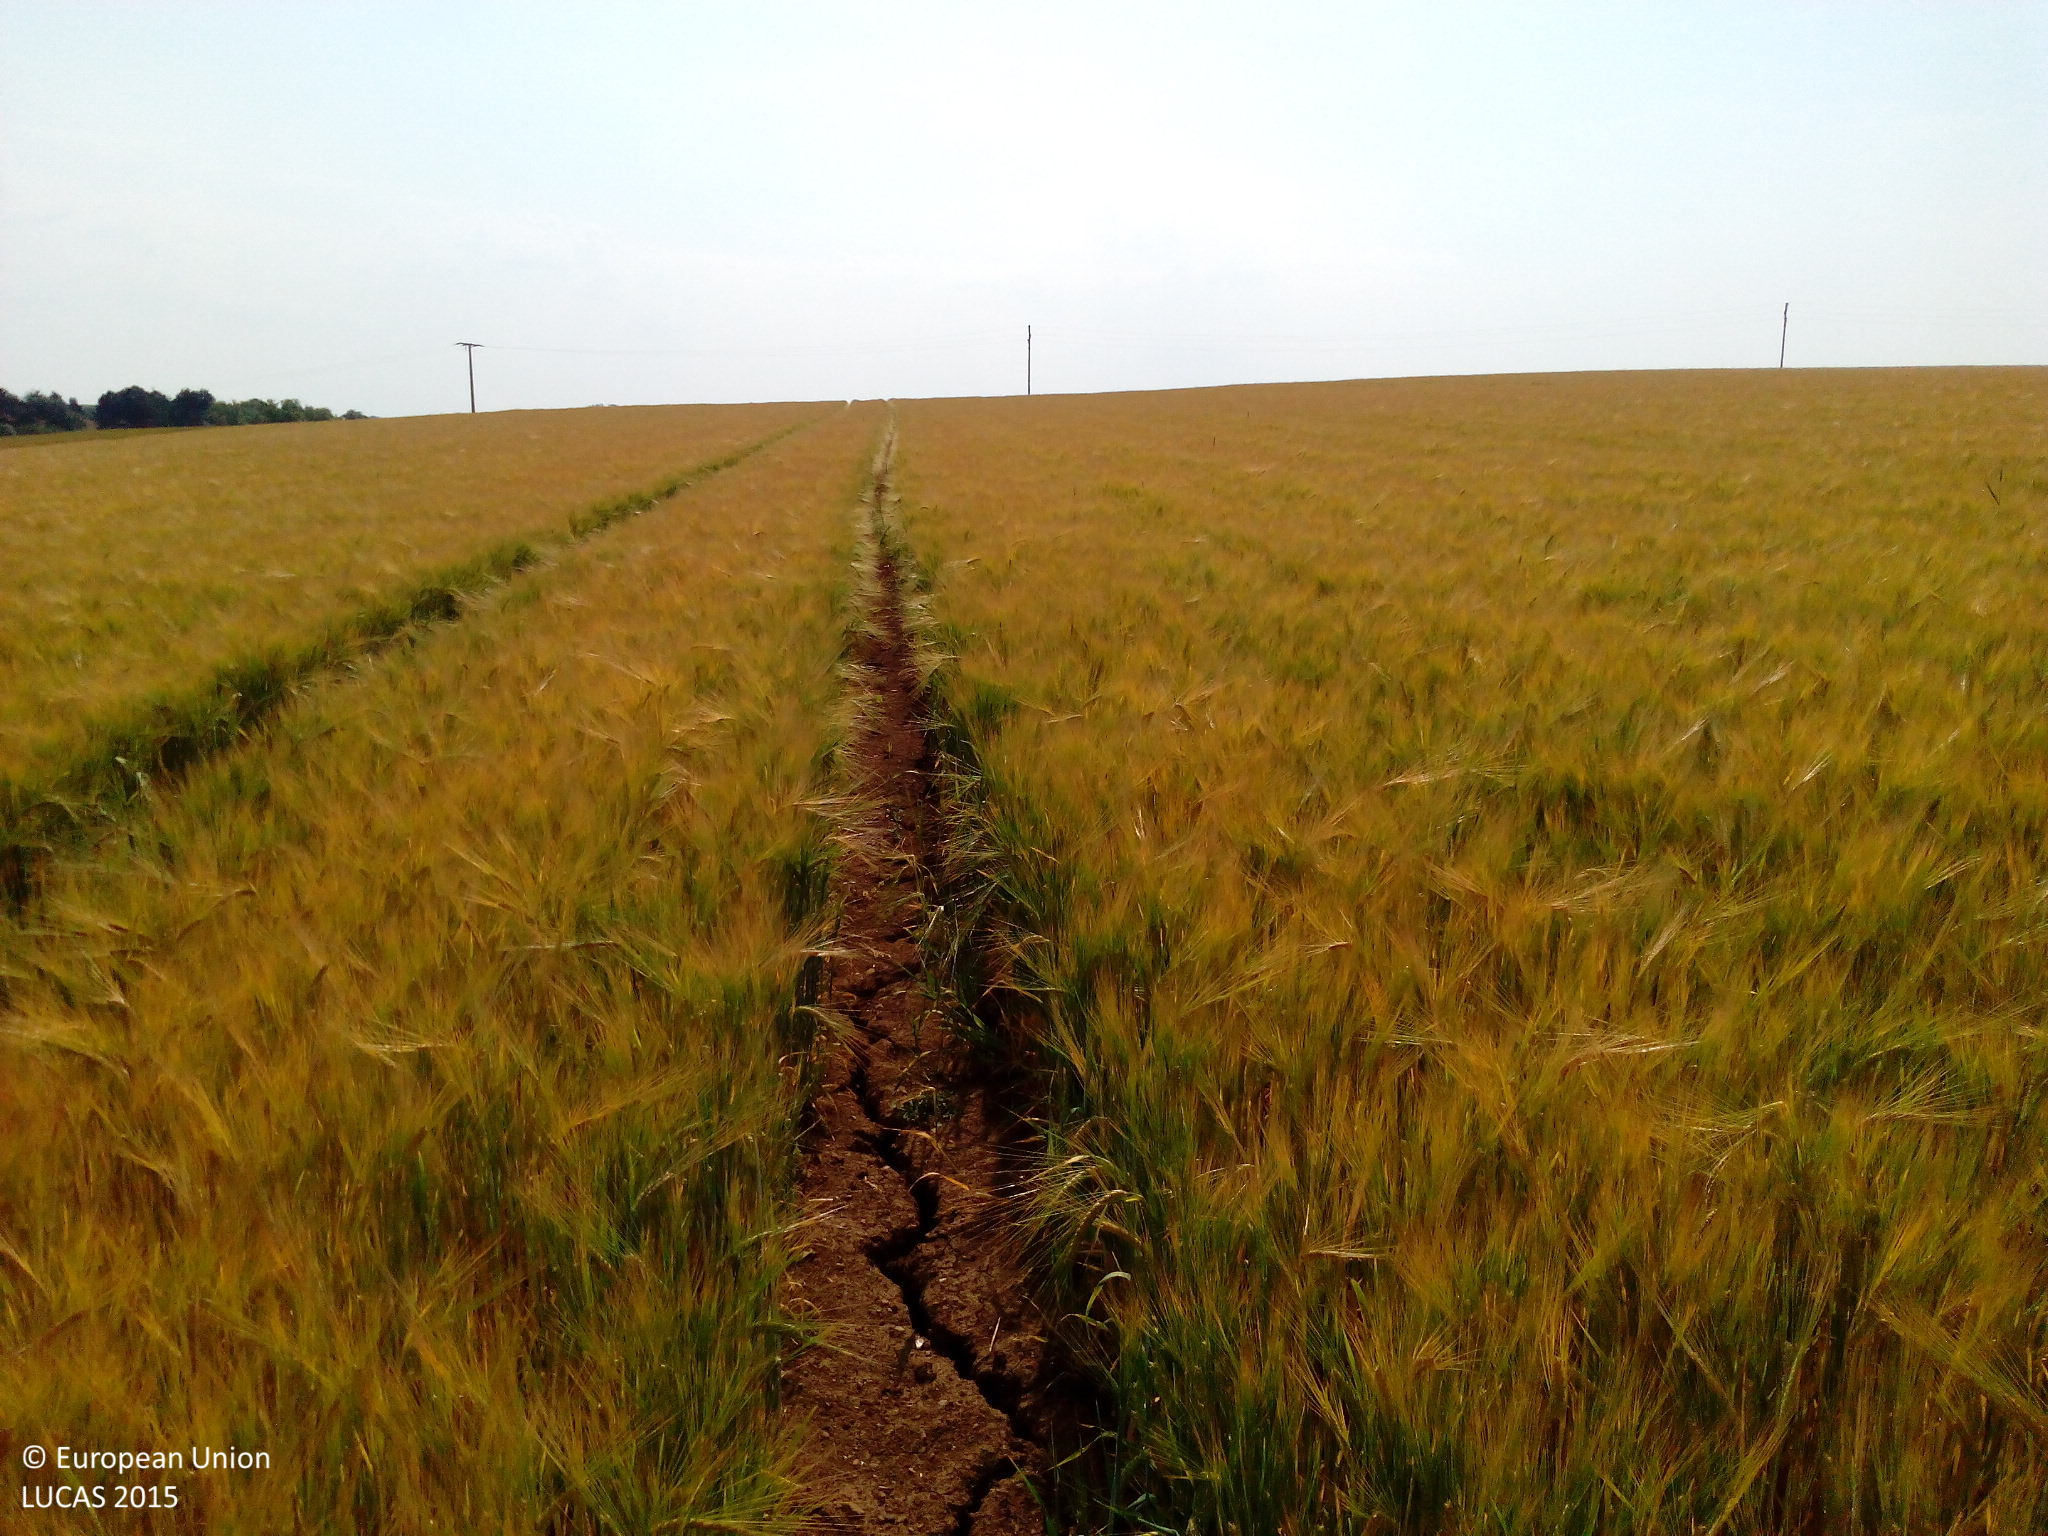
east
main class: Cropland
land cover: Barley
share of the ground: > 75 %
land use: Agriculture (excluding fallow land and kitchen gardens)
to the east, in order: Barley; Common wheat; Electric lines; Common wheat; Grass margins; Tracks; Sugar beet
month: July
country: DE
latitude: 49.6086
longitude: 9.8478
